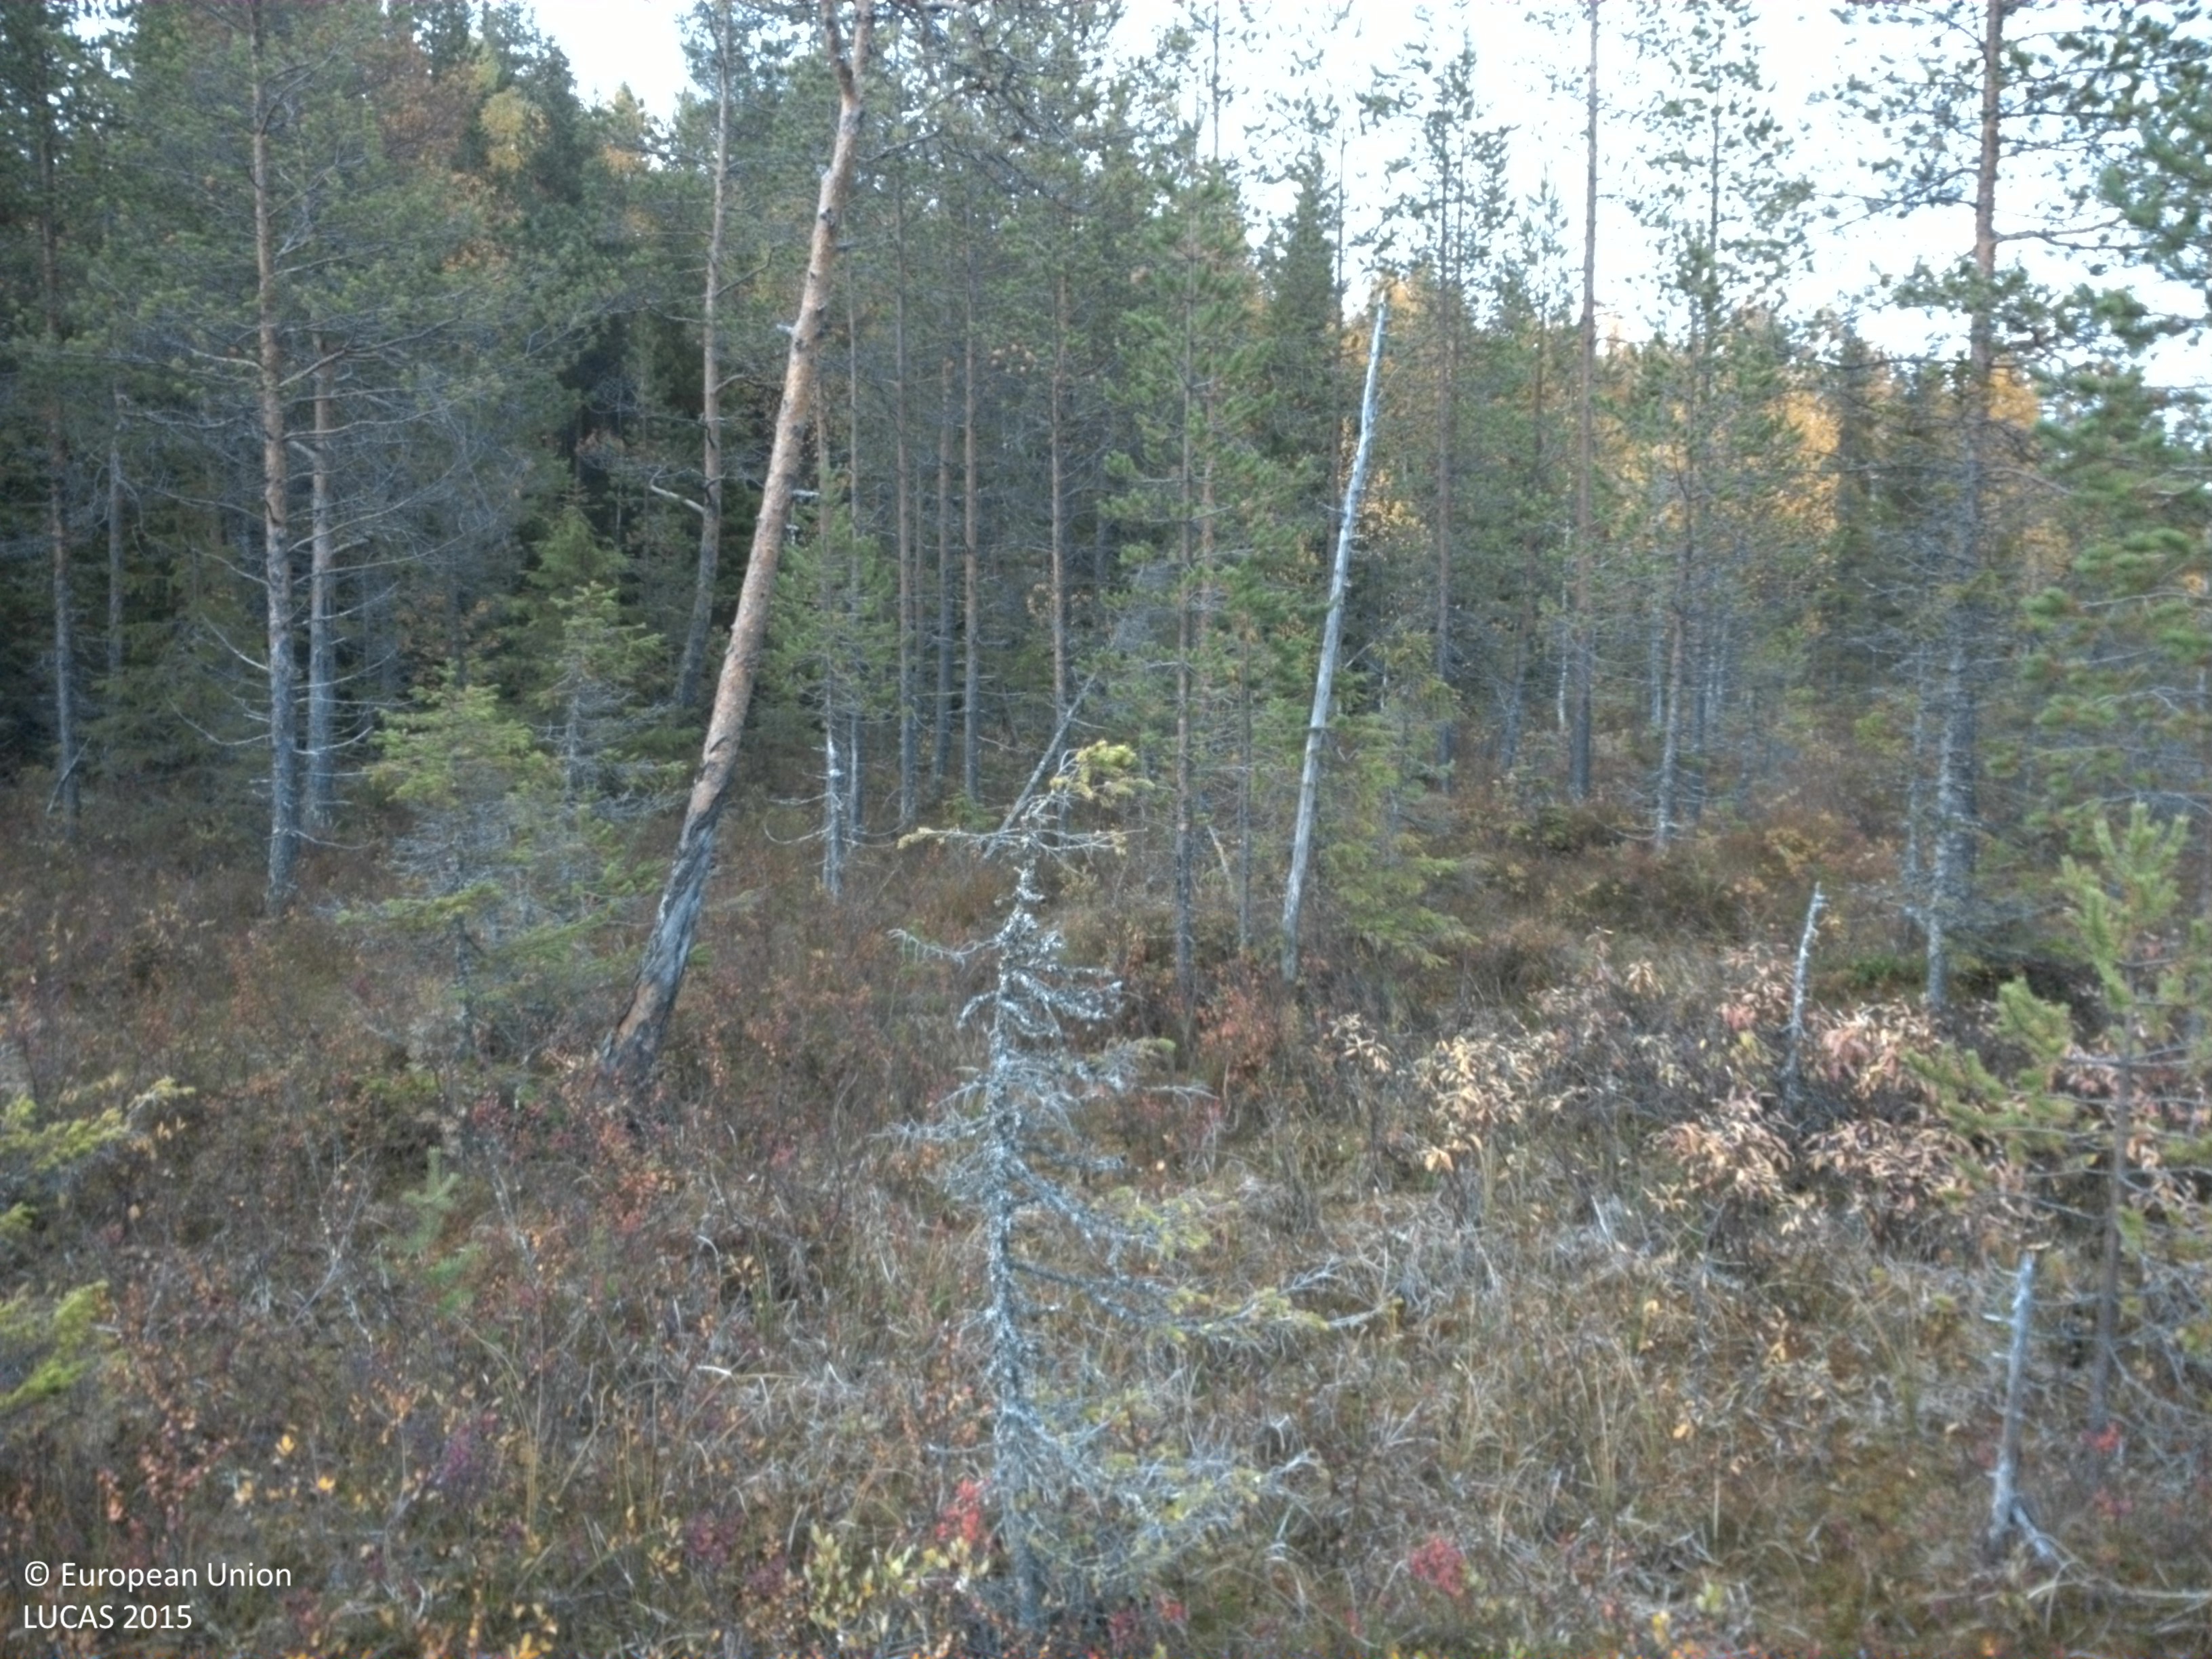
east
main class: Shrubland
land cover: Shrubland with sparse tree cover
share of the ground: 50 - 75 %
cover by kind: shrubs 45 %, herbaceous plants 25 %, lichens and mosses 25 %, coniferous forest trees 5 %
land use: Semi-natural and natural areas not in use
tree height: < 5 m
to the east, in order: Shrubland with sparse tree cover; Pine dominated coniferous woodland; Spruce dominated mixed woodland; Ditches and canals; Spruce dominated mixed woodland; Other mixed woodland; Pine dominated coniferous woodland
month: September
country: SE
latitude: 65.0404
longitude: 17.0361
